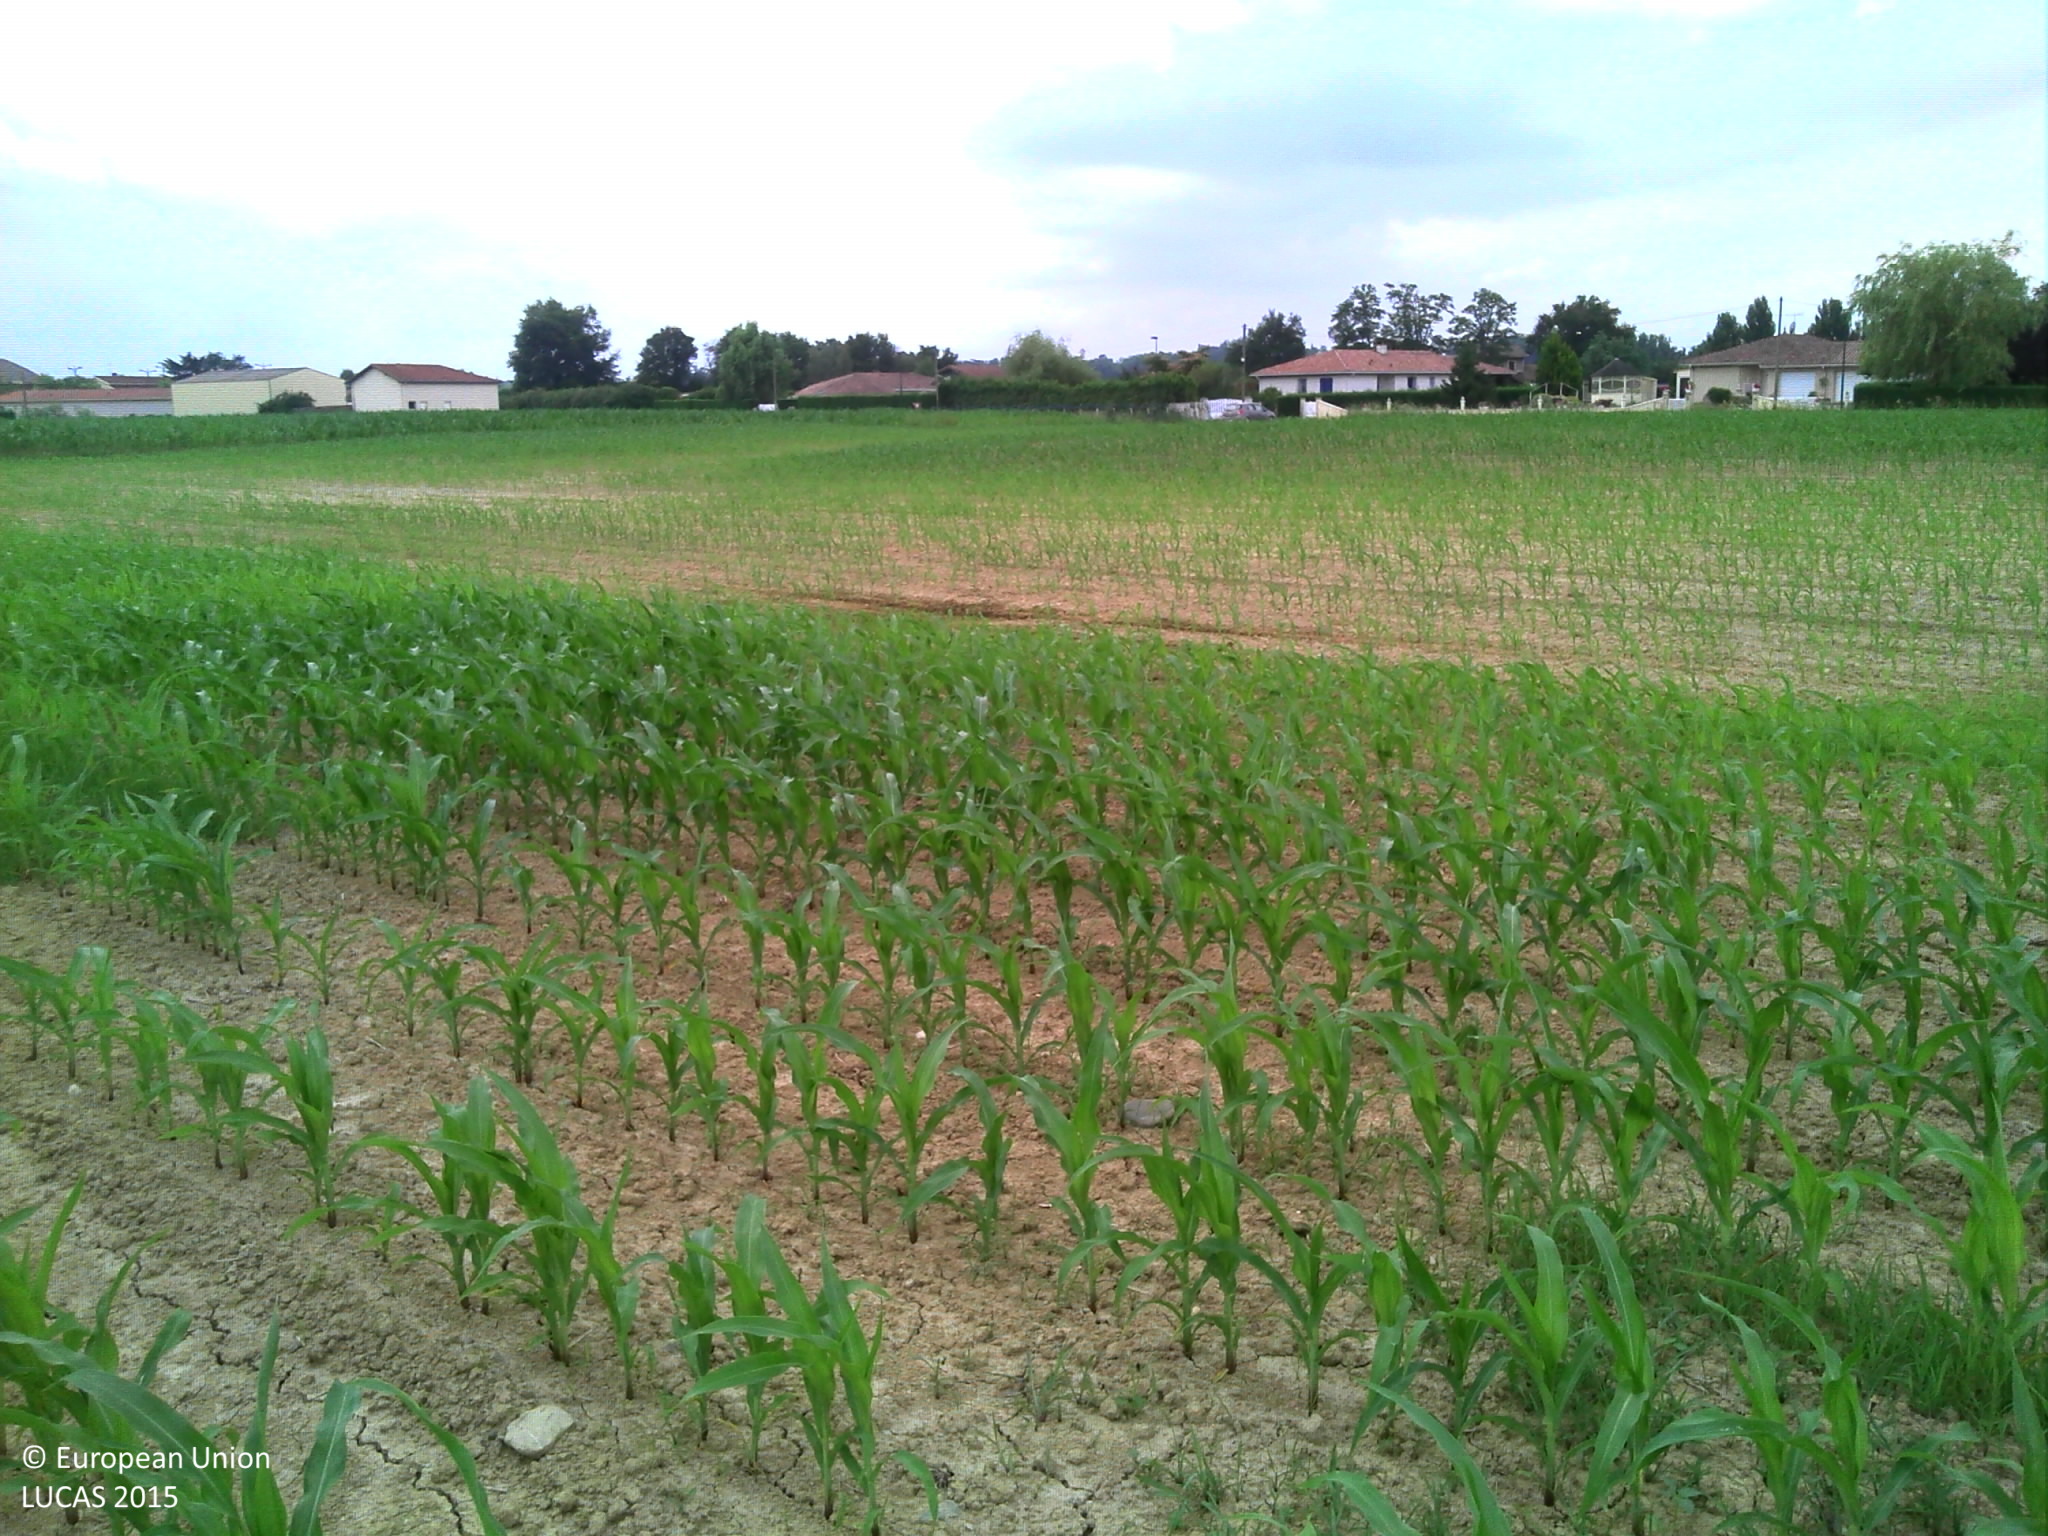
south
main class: Cropland
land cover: Maize
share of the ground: 50 - 75 %
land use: Agriculture (excluding fallow land and kitchen gardens)
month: July
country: FR
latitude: 43.6235
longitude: -0.7818
